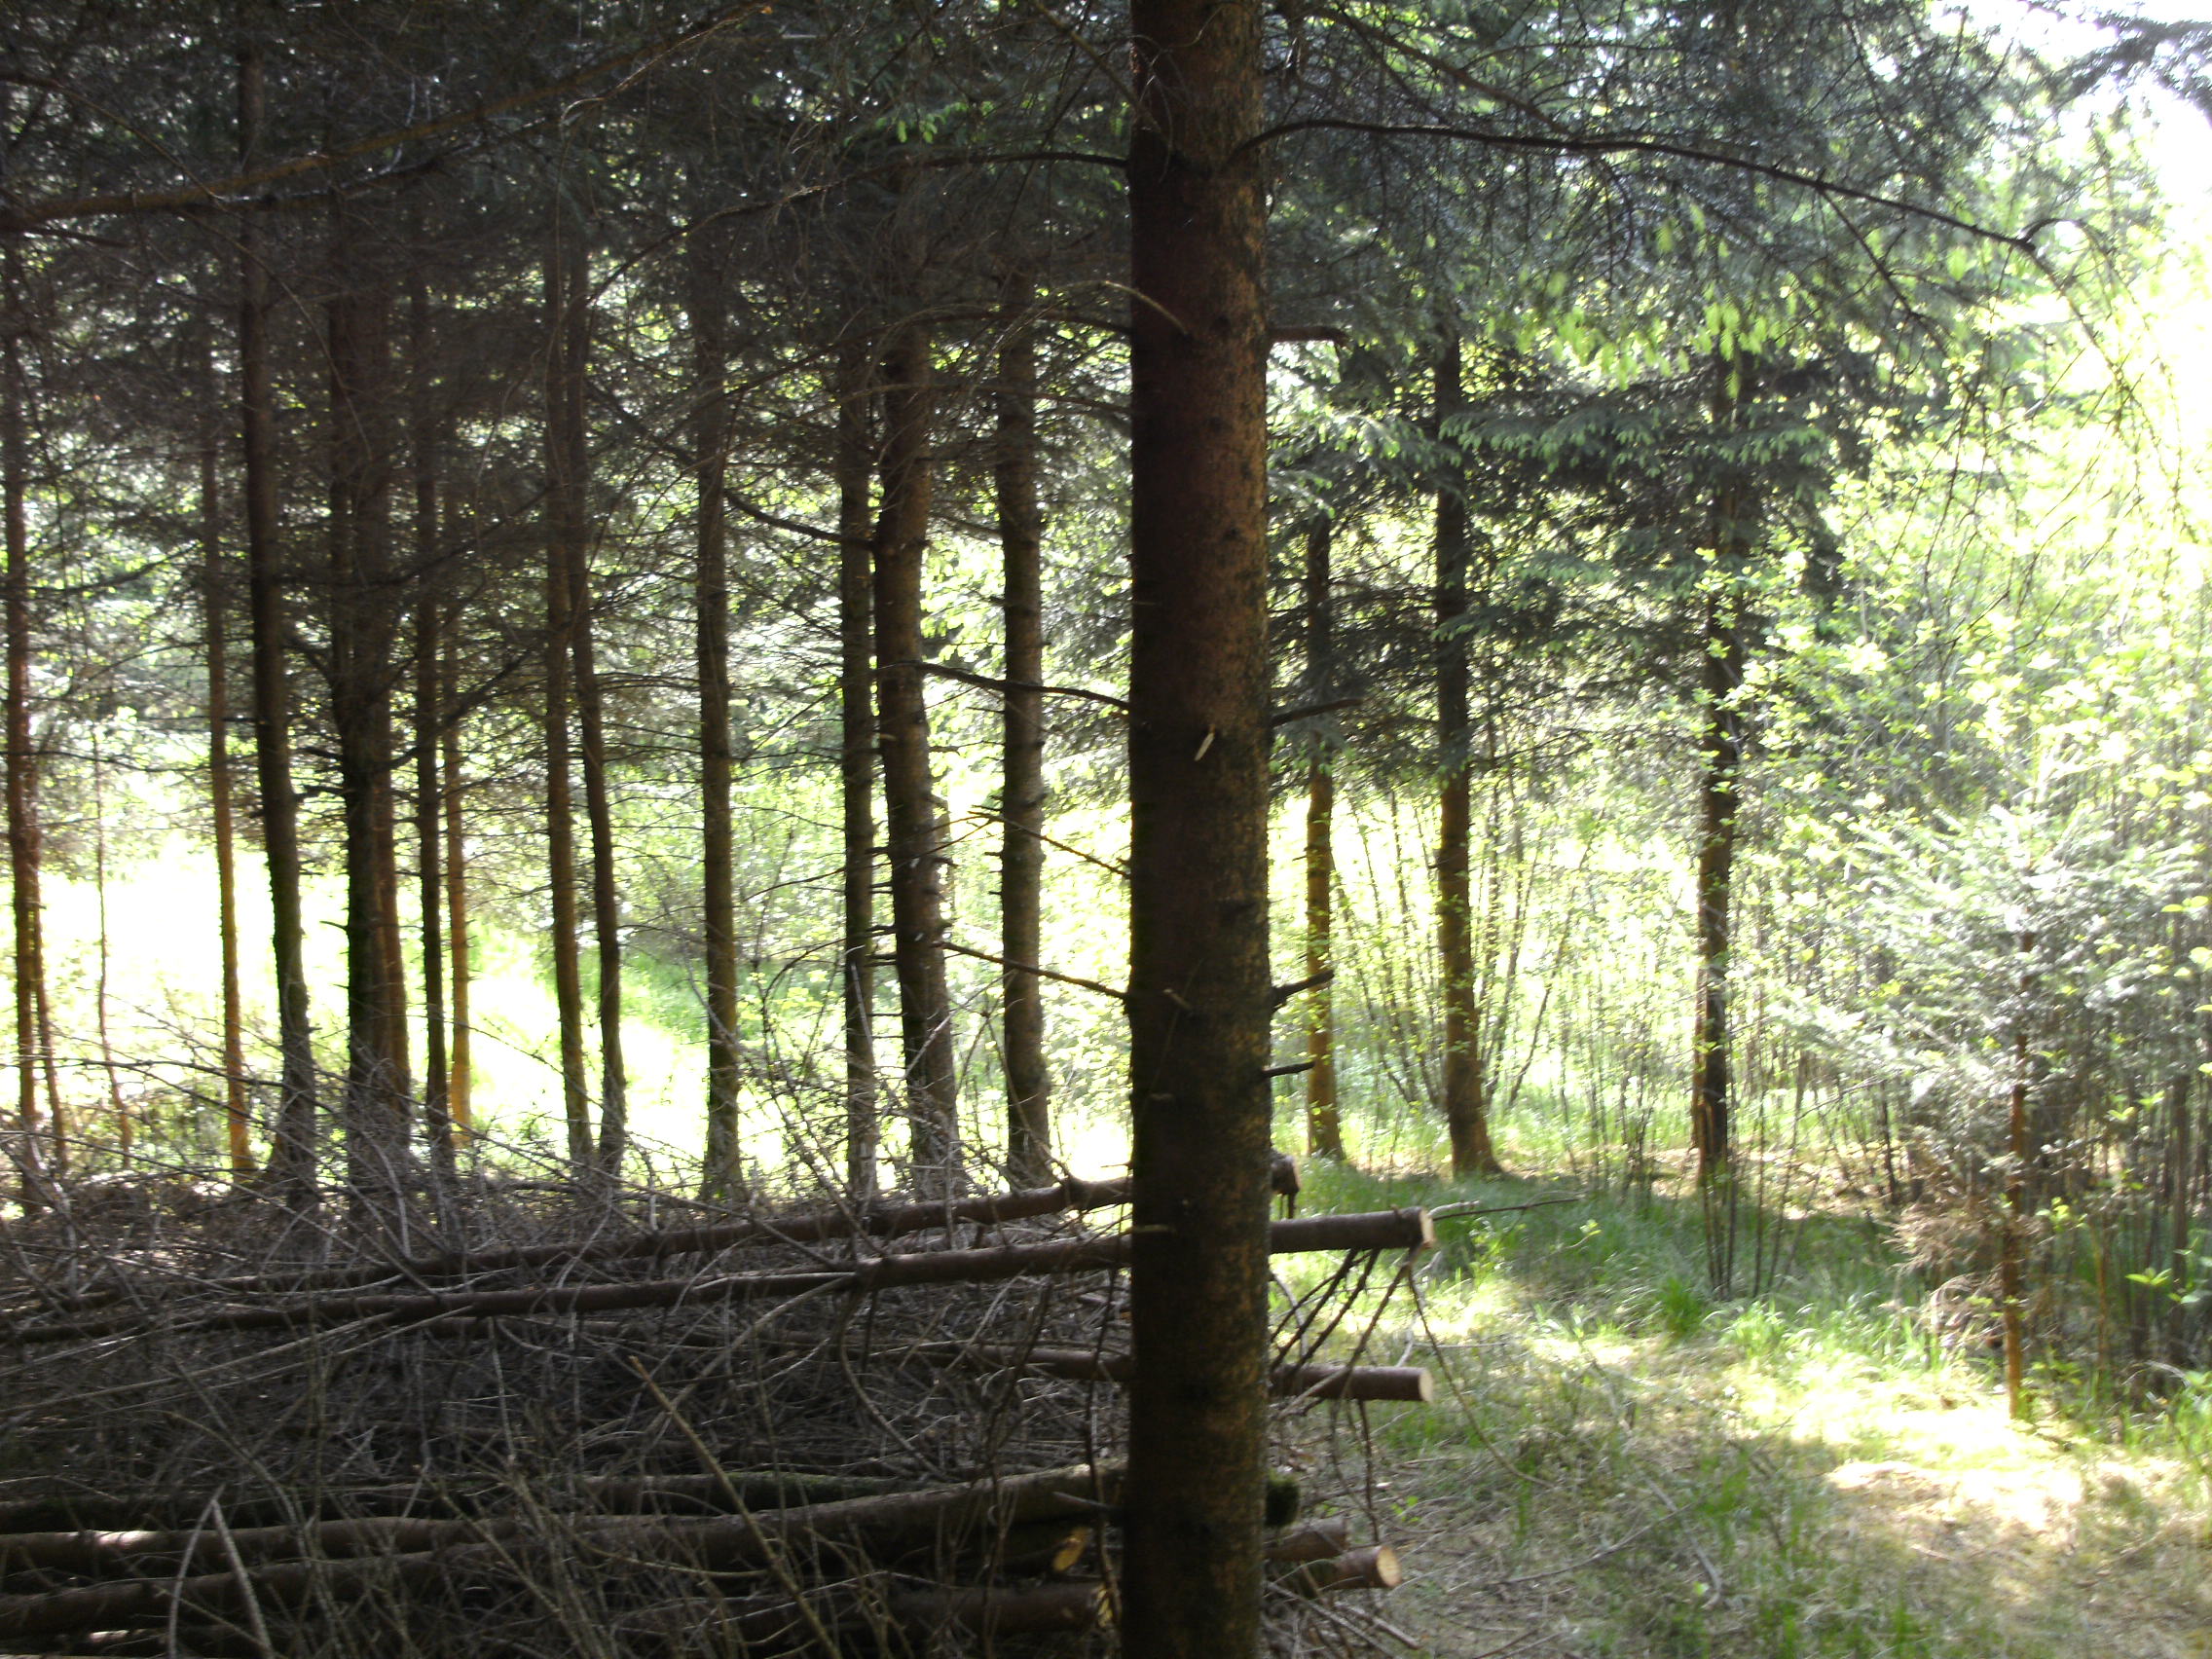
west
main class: Woodland
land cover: Spruce dominated coniferous woodland
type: hemiboreal forest and nemoral coniferous forest and mixed broadleaved-coniferous forest
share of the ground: > 75 %
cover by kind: coniferous forest trees 100 %
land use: Forestry
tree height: > 5 m
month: May
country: AT
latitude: 48.4364
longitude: 13.5544
